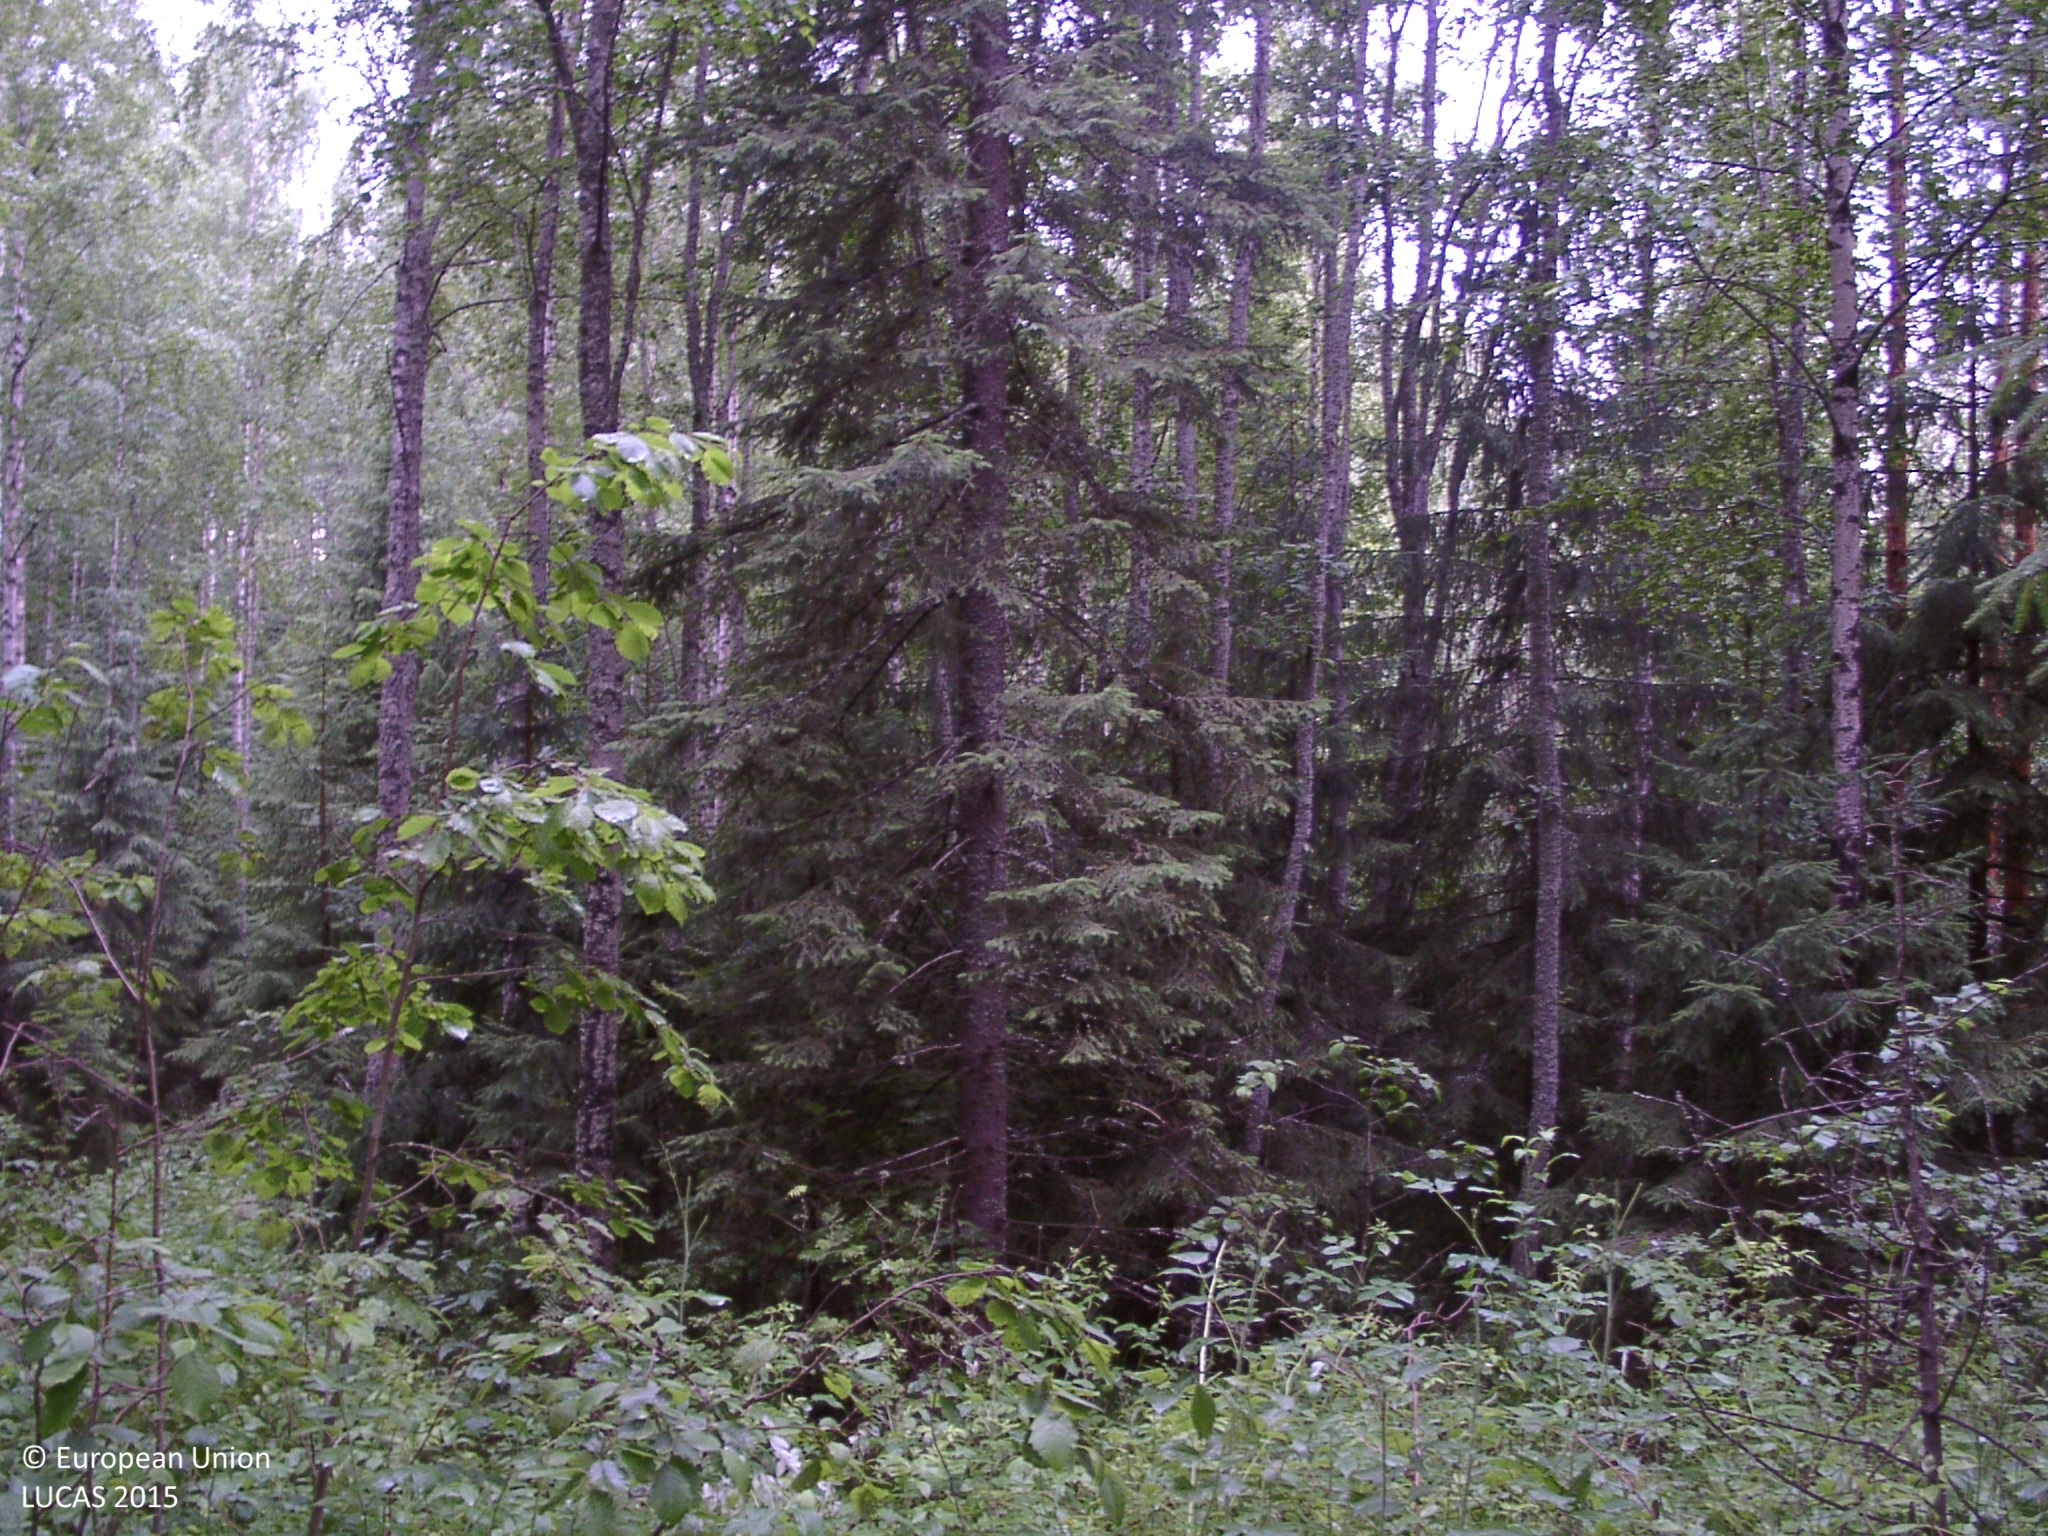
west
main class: Woodland
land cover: Spruce dominated mixed woodland
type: boreal forest
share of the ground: 50 - 75 %
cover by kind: coniferous forest trees 35 %, broadleaved forest trees 35 %, shrubs 15 %, herbaceous plants 10 %, lichens and mosses 5 %
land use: Forestry
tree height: > 5 m
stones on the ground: < 10 %
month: July
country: FI
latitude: 61.9557
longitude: 25.2691
